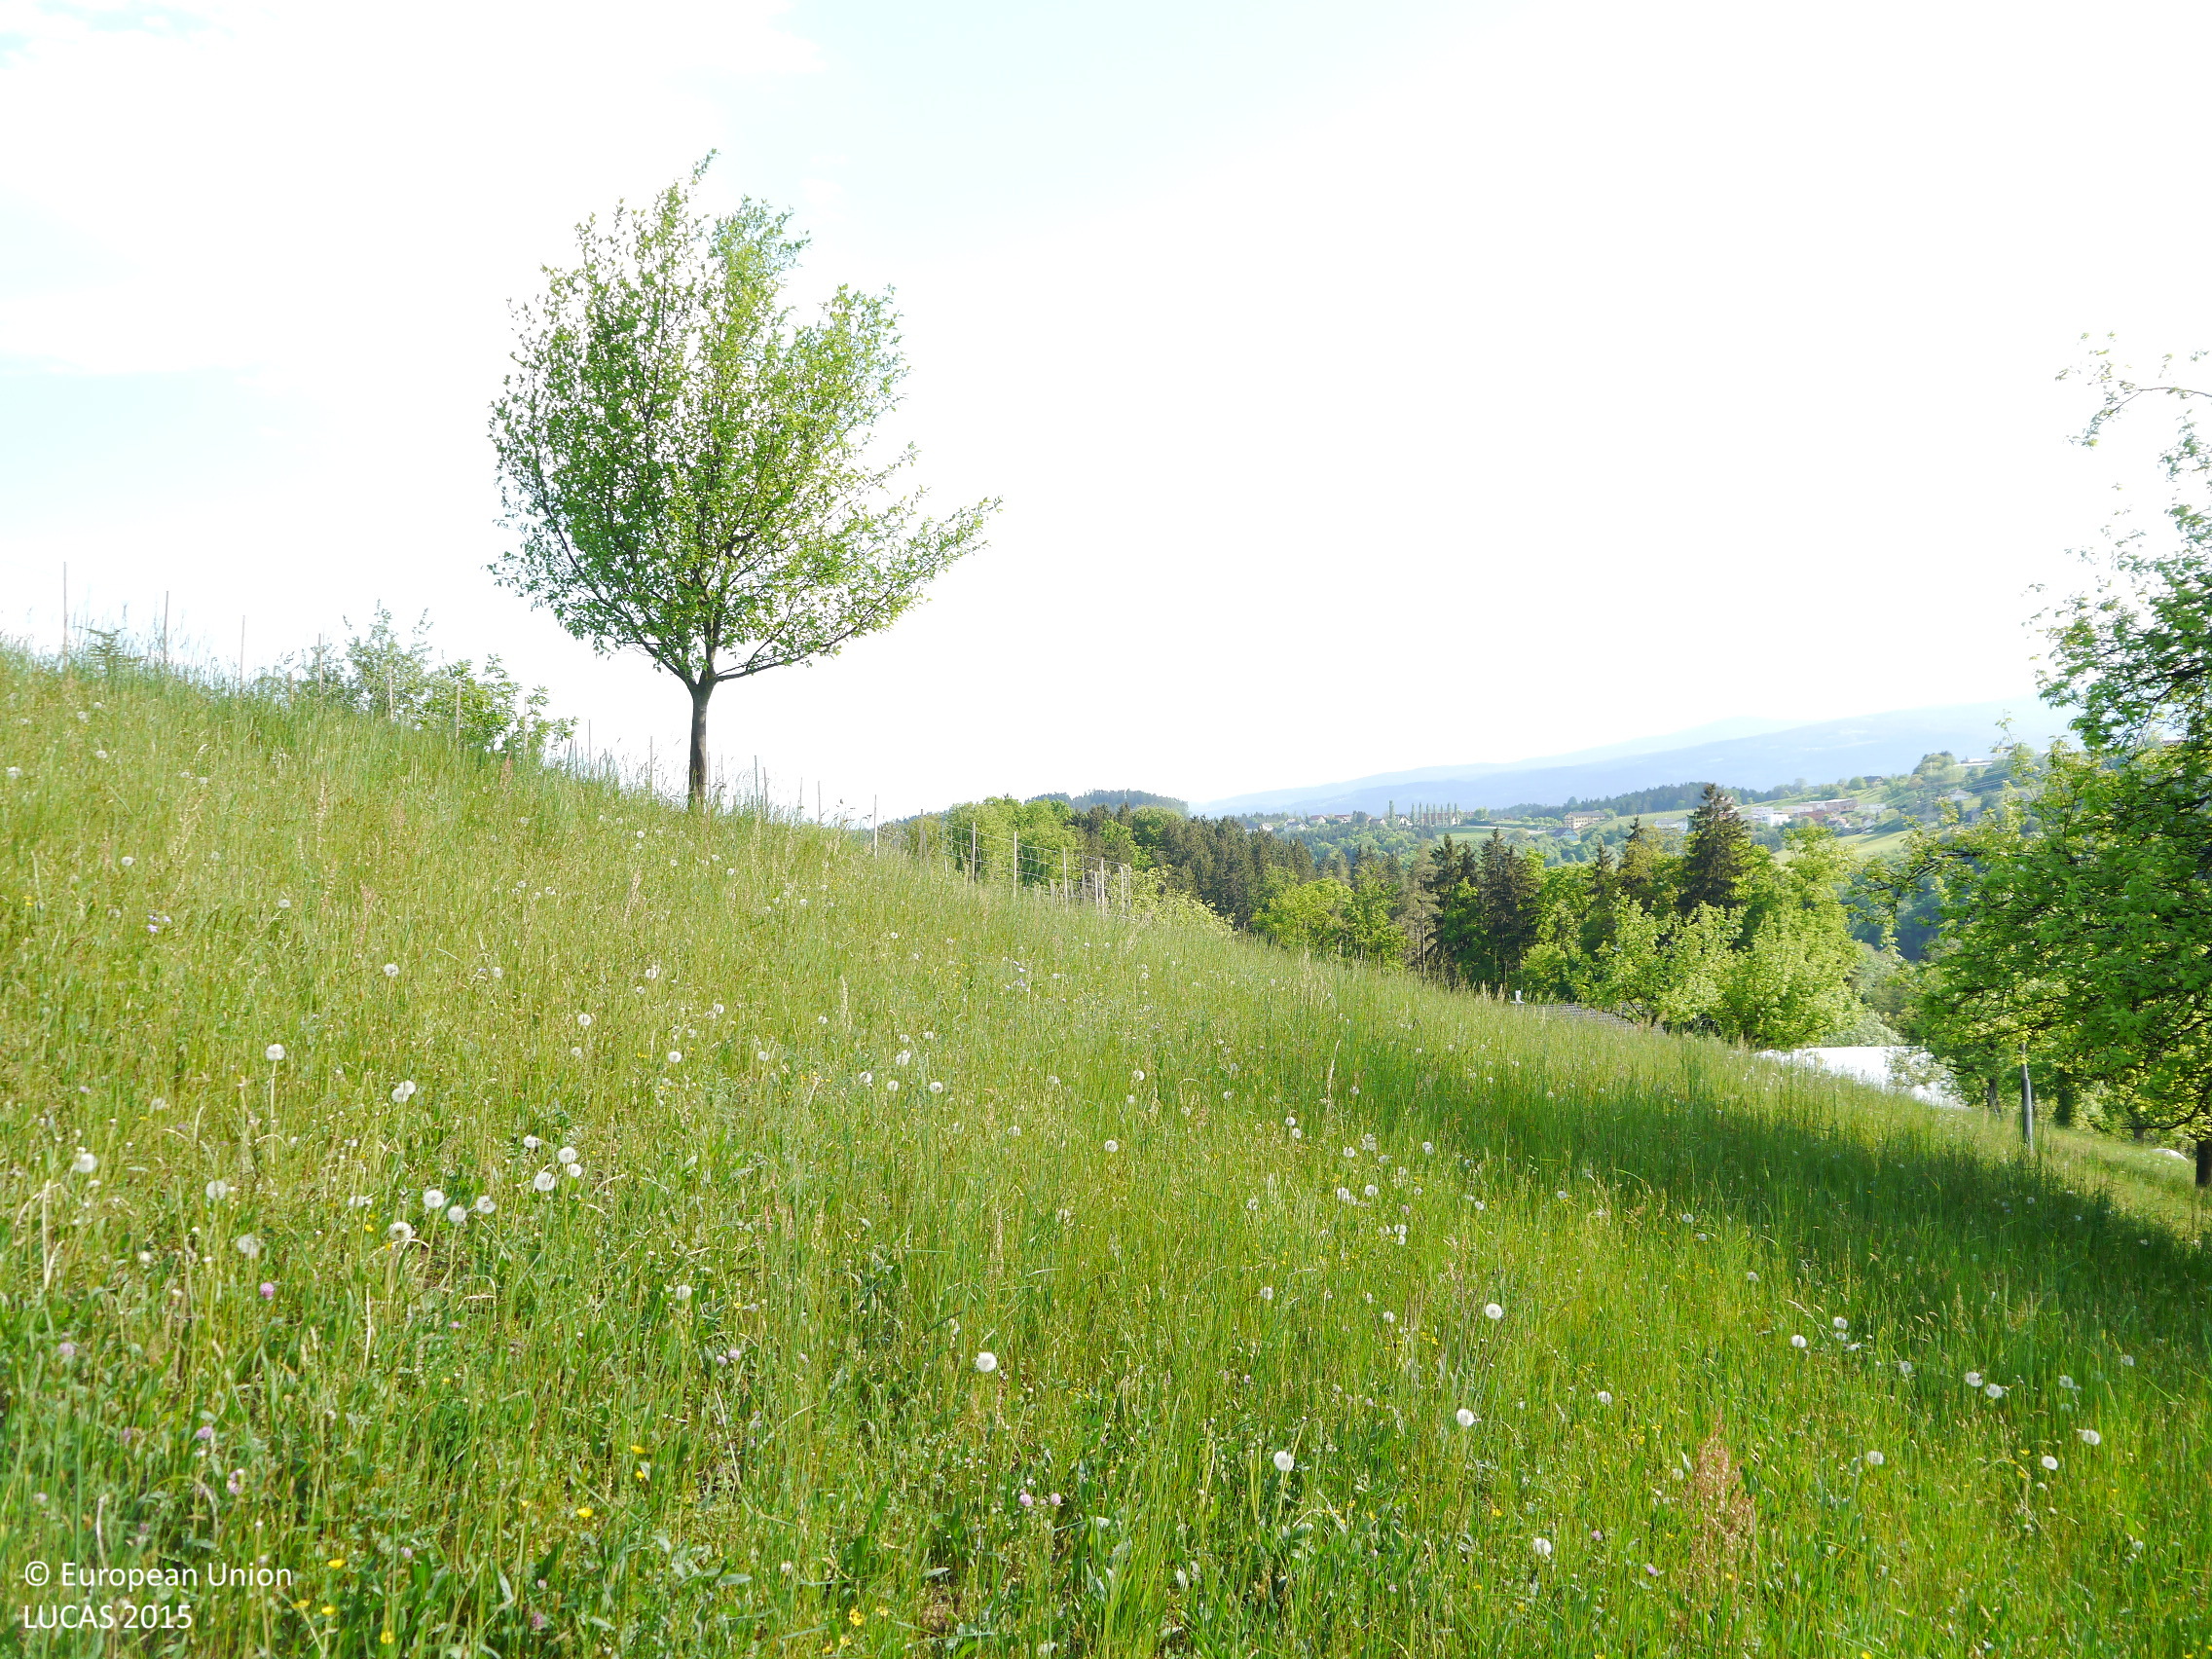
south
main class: Cropland
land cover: Apple fruit
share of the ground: 50 - 75 %
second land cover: Grassland without tree/shrub cover
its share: > 75 %
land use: Agriculture (excluding fallow land and kitchen gardens)
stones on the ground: < 10 %
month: May
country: AT
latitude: 47.0690
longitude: 15.2799
